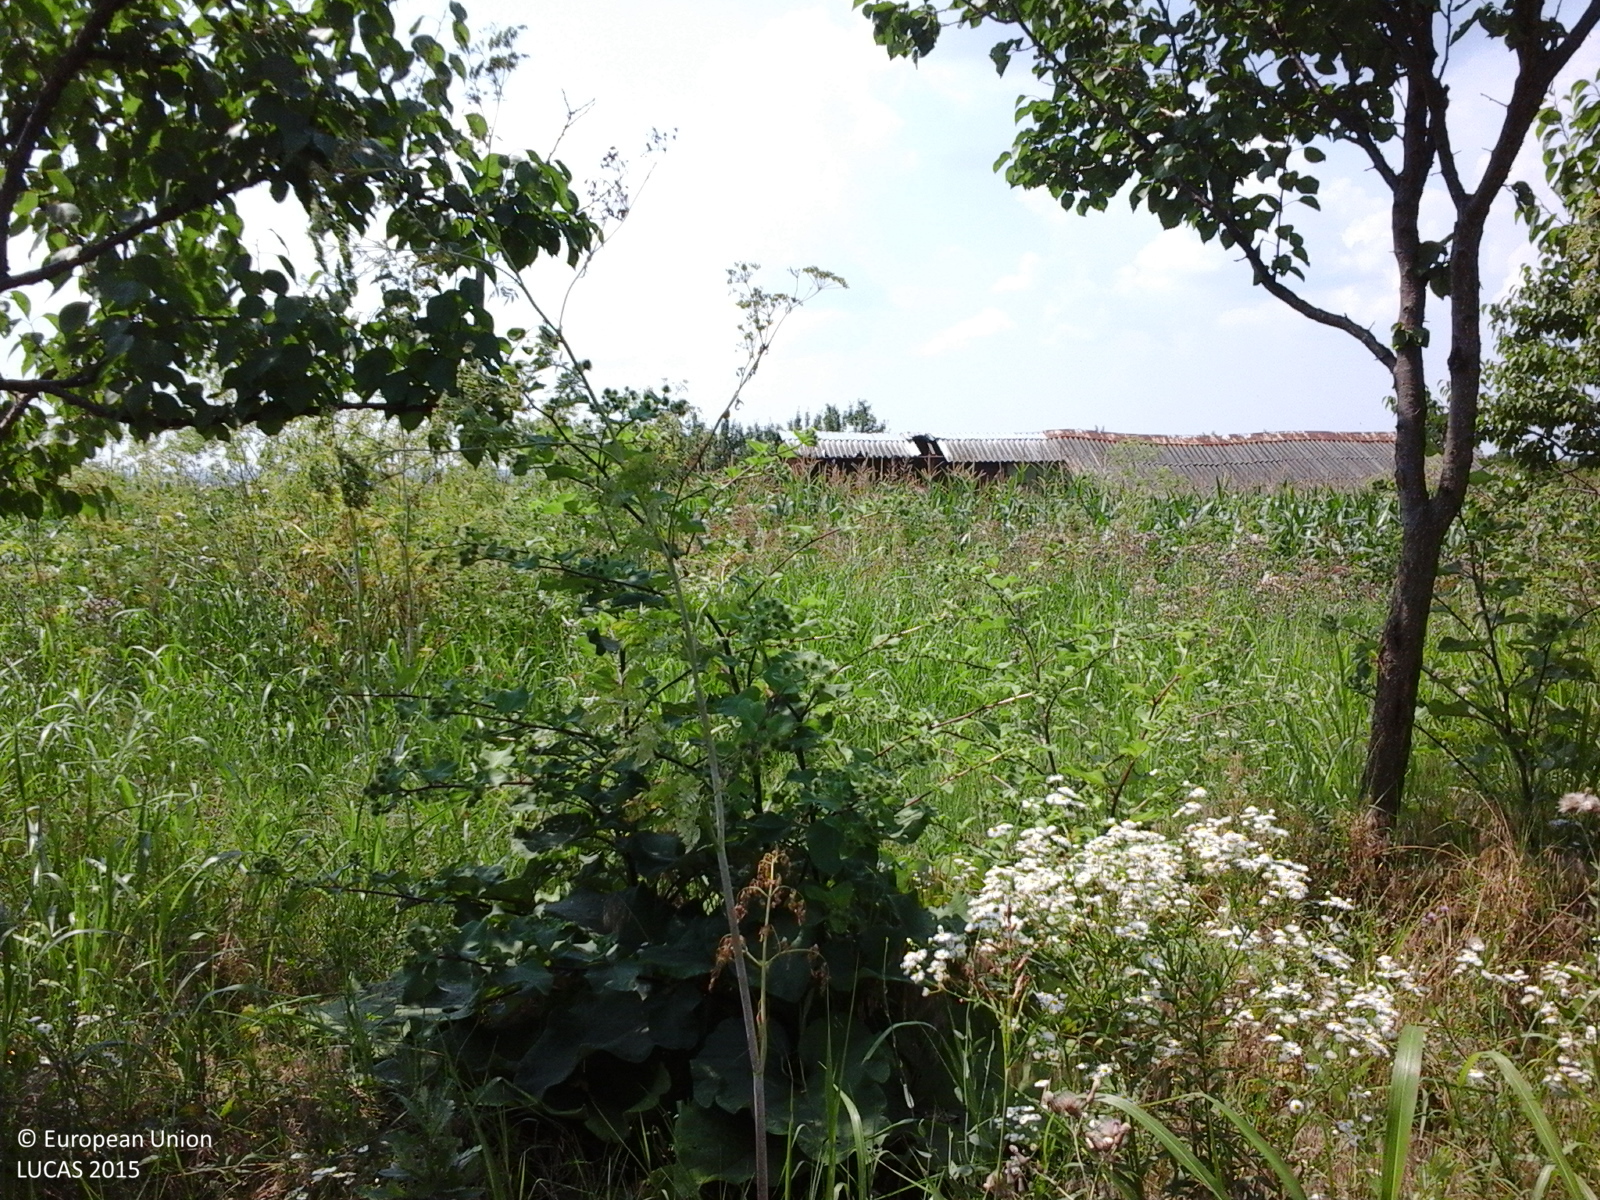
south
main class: Cropland
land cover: Other fruit trees and berries
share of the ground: 50 - 75 %
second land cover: Grassland without tree/shrub cover
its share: > 75 %
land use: Agriculture (excluding fallow land and kitchen gardens)
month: July
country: RO
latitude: 43.8422
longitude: 25.4703
